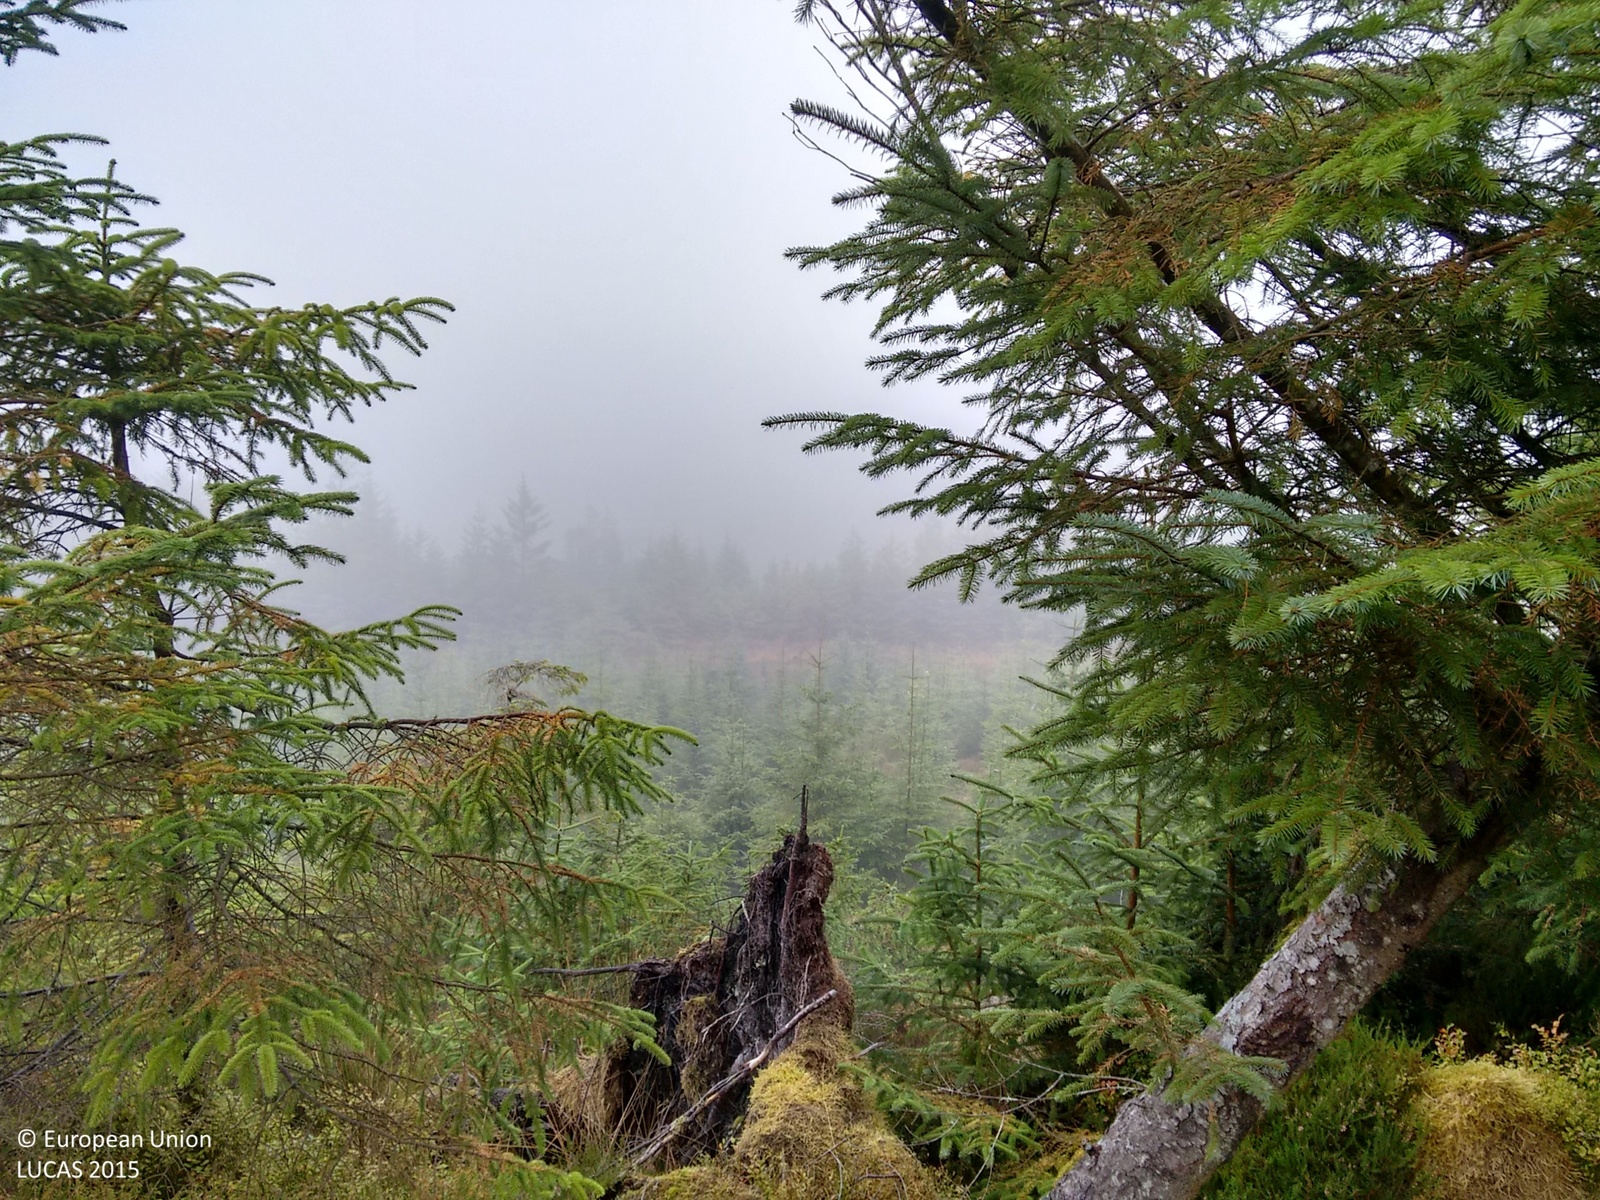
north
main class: Woodland
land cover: Spruce dominated coniferous woodland
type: exotic forest
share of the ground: > 75 %
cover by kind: coniferous forest trees 100 %
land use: Forestry
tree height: > 5 m
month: October
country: GB
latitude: 54.4523
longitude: -7.8908
